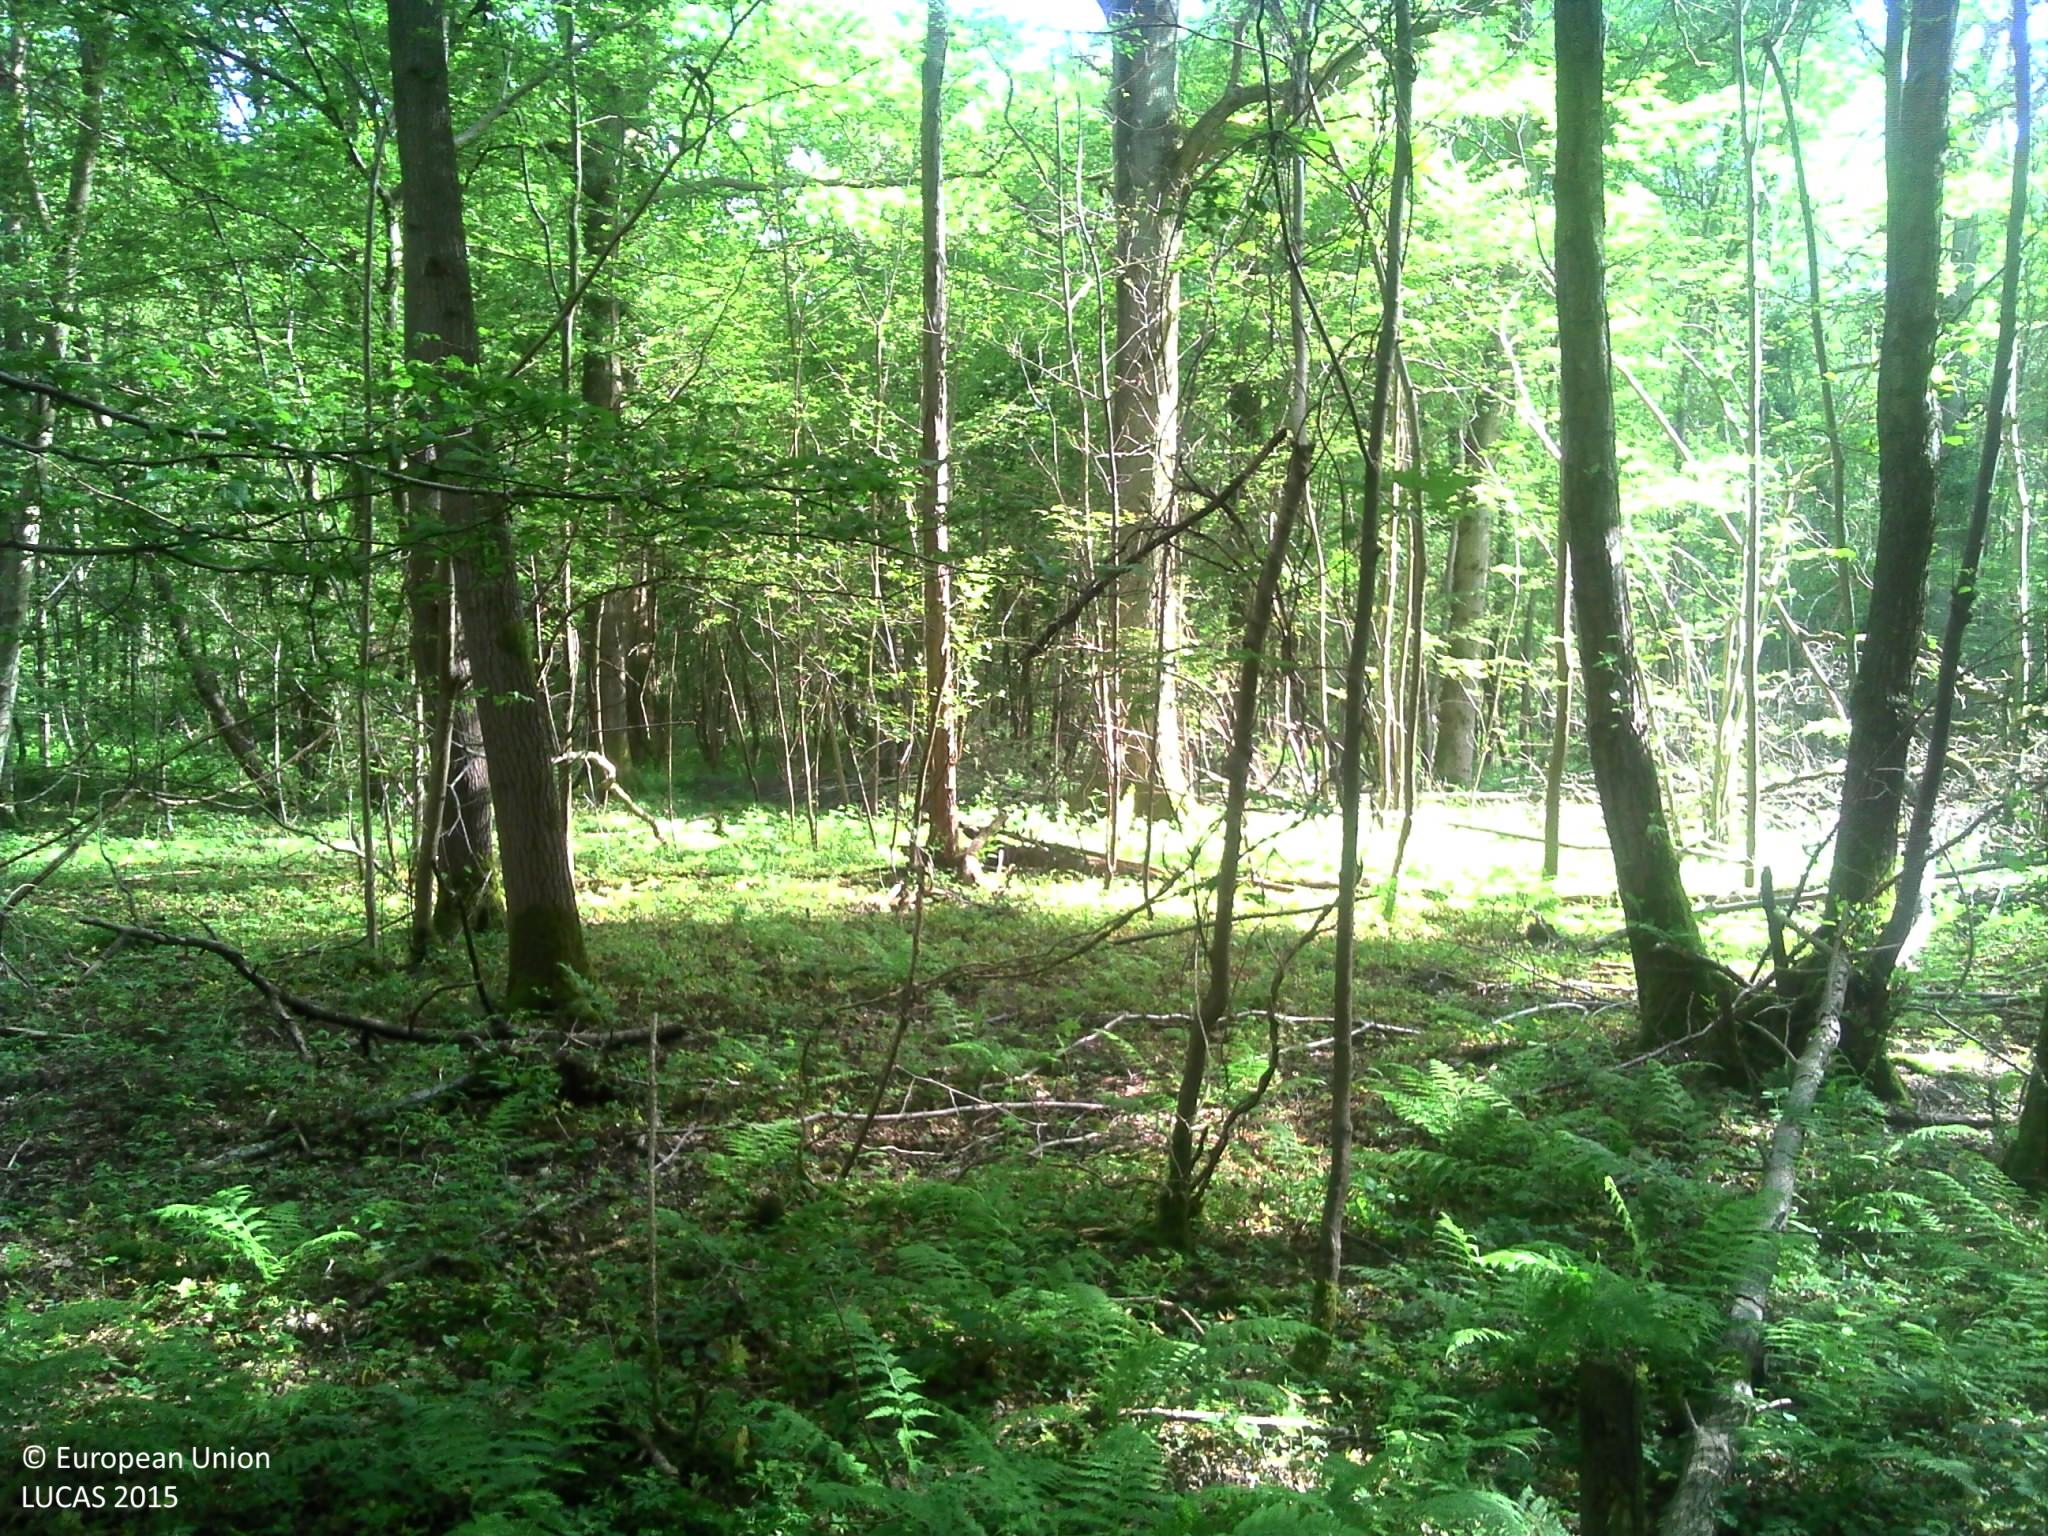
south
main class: Woodland
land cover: Broadleaved woodland
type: mesophytic deciduous forest
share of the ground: > 75 %
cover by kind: broadleaved forest trees 85 %, herbaceous plants 15 %
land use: Forestry
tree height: > 5 m
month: June
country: FR
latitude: 49.6769
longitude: 3.2426
